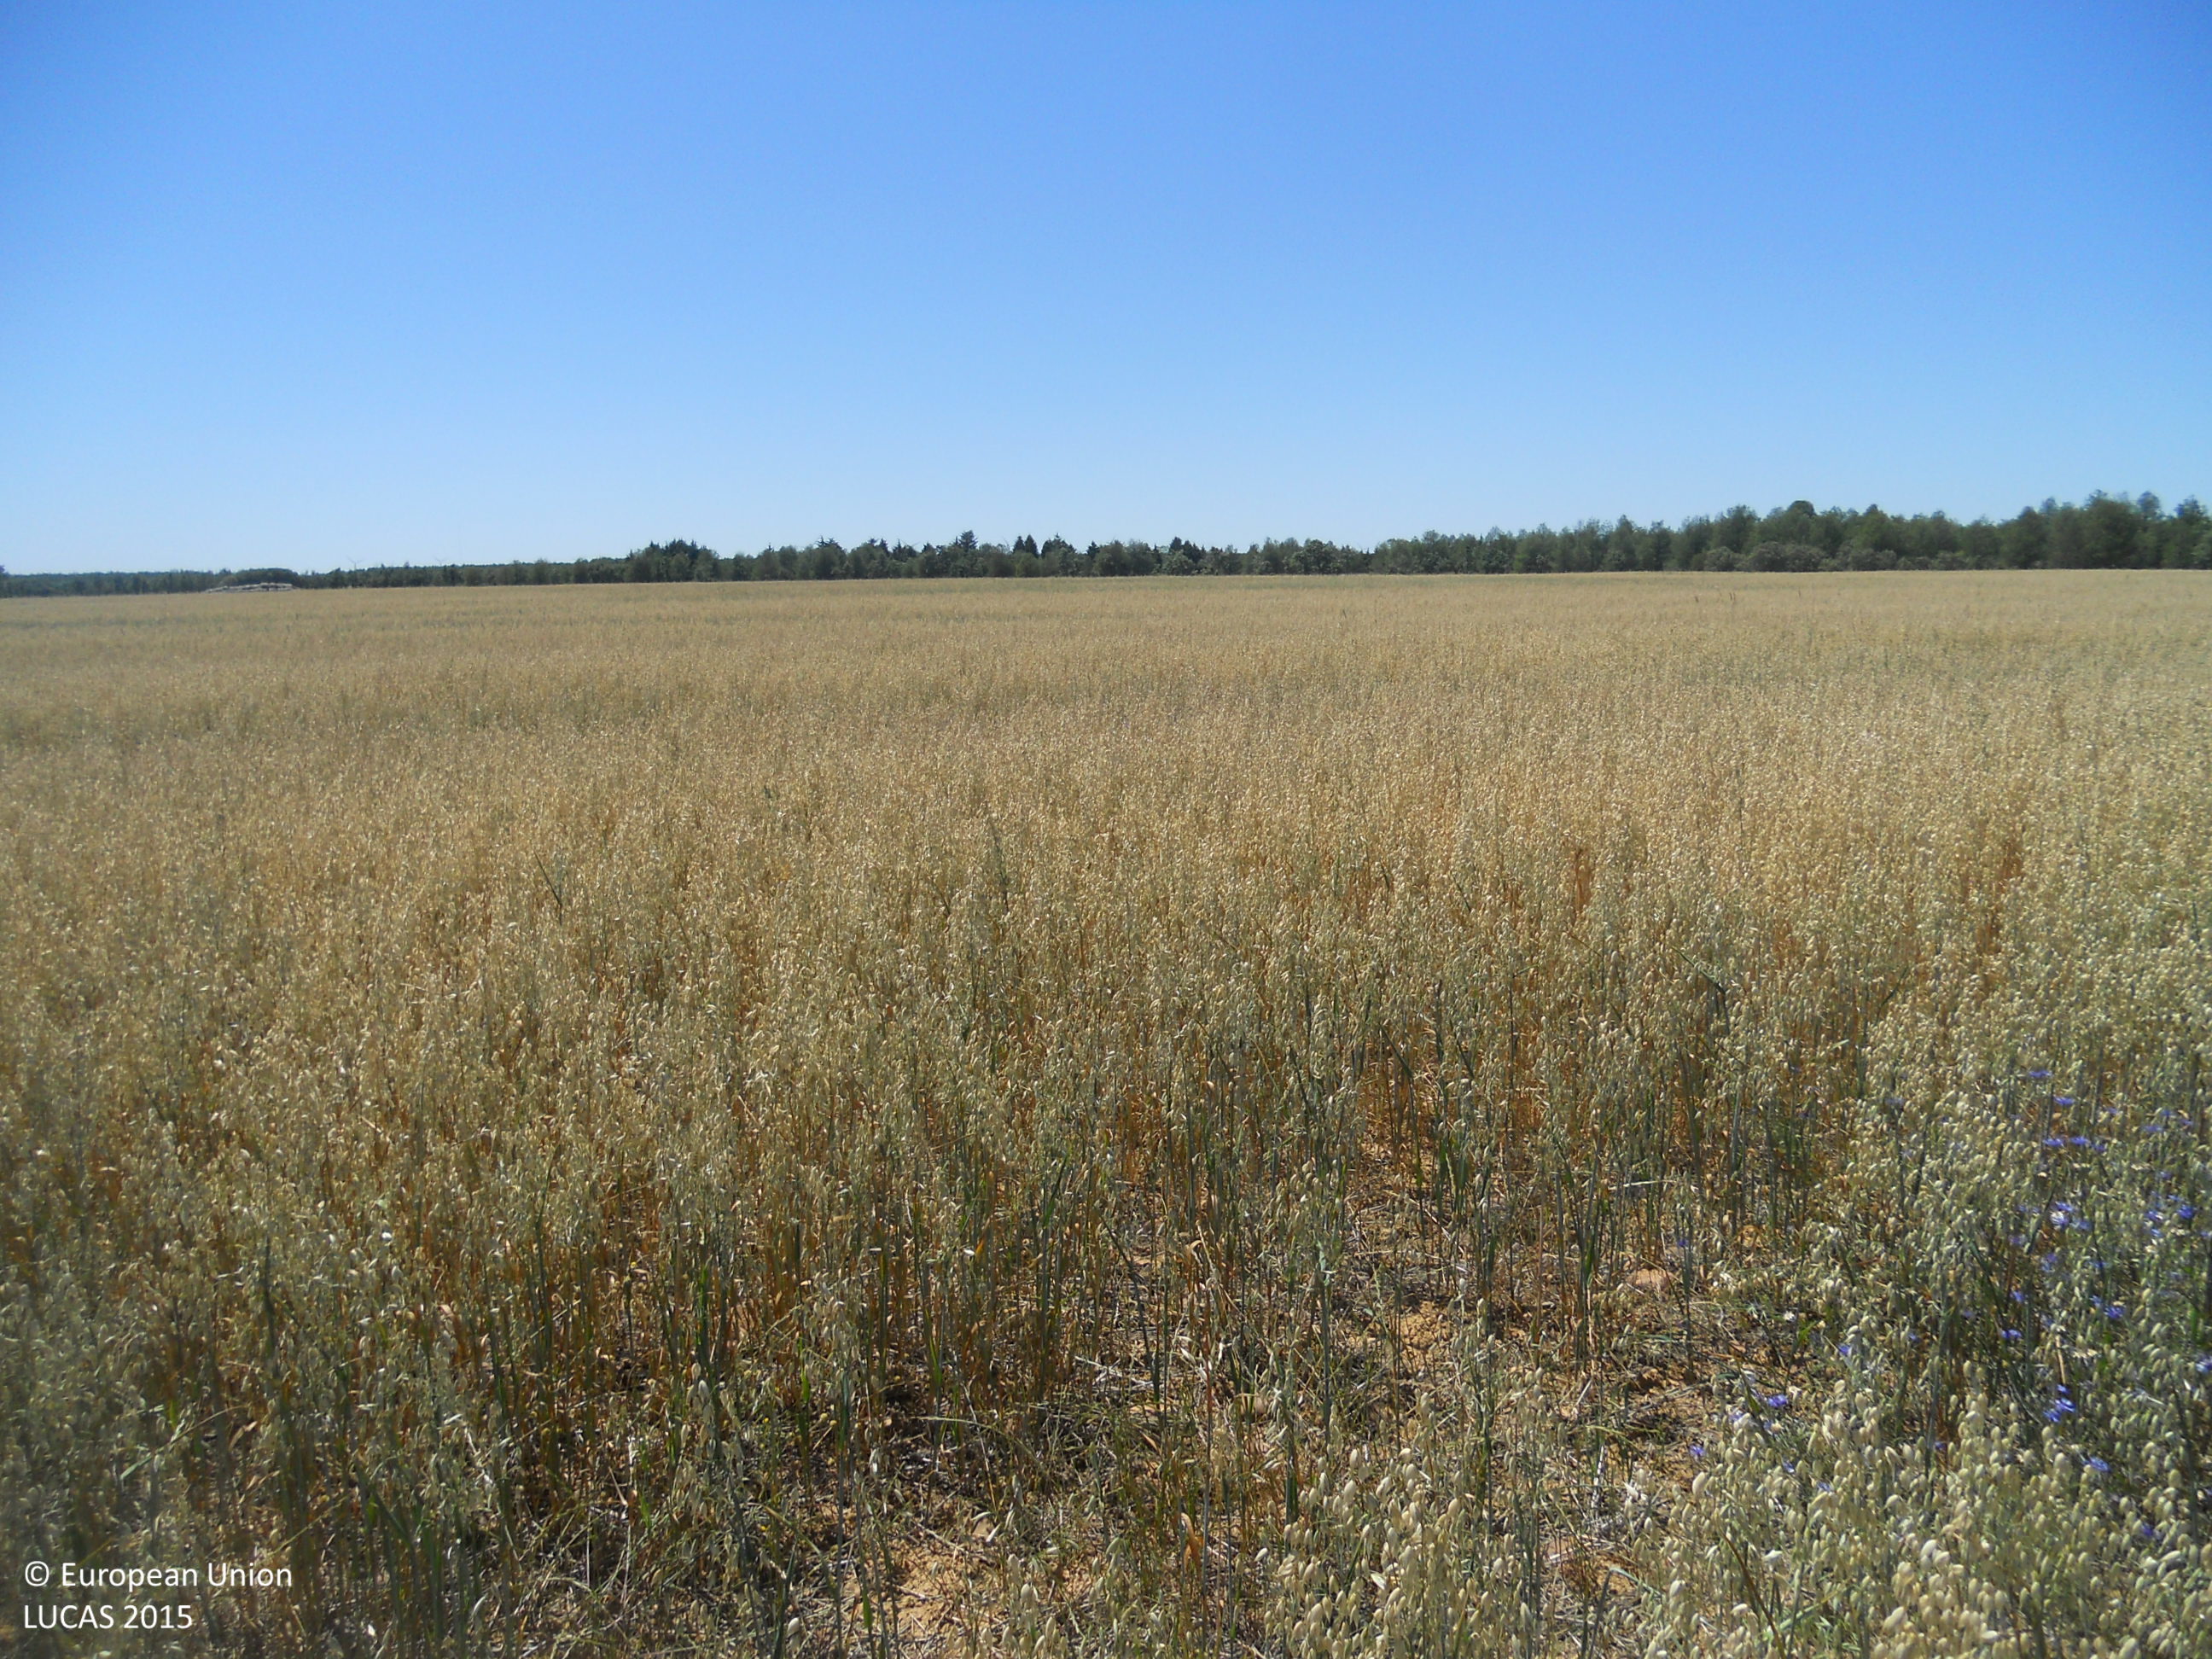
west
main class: Cropland
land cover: Oats
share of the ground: > 75 %
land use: Agriculture (excluding fallow land and kitchen gardens)
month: June
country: ES
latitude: 42.4323
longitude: -4.8497
